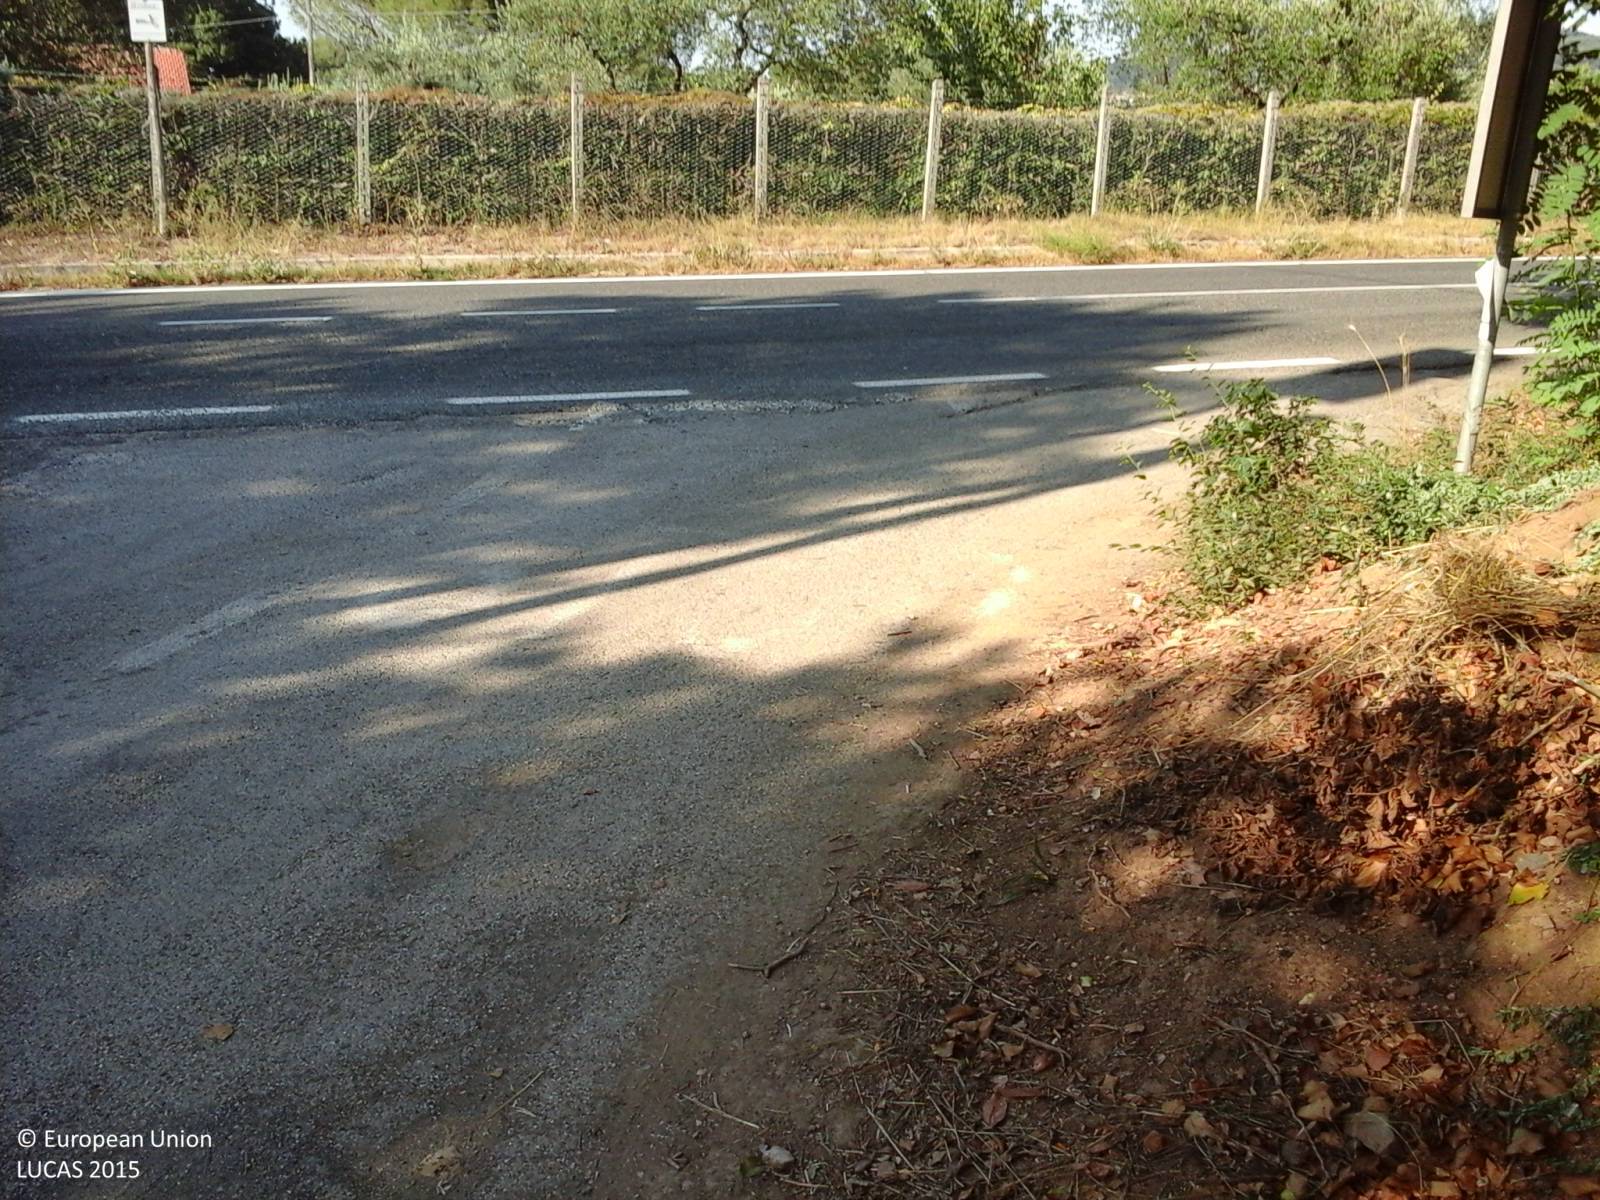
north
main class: Cropland
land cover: Olive groves
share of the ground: > 75 %
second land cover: Spontaneously vegetated surfaces
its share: > 75 %
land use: Agriculture (excluding fallow land and kitchen gardens)
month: August
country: IT
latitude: 42.1266
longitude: 12.0852
